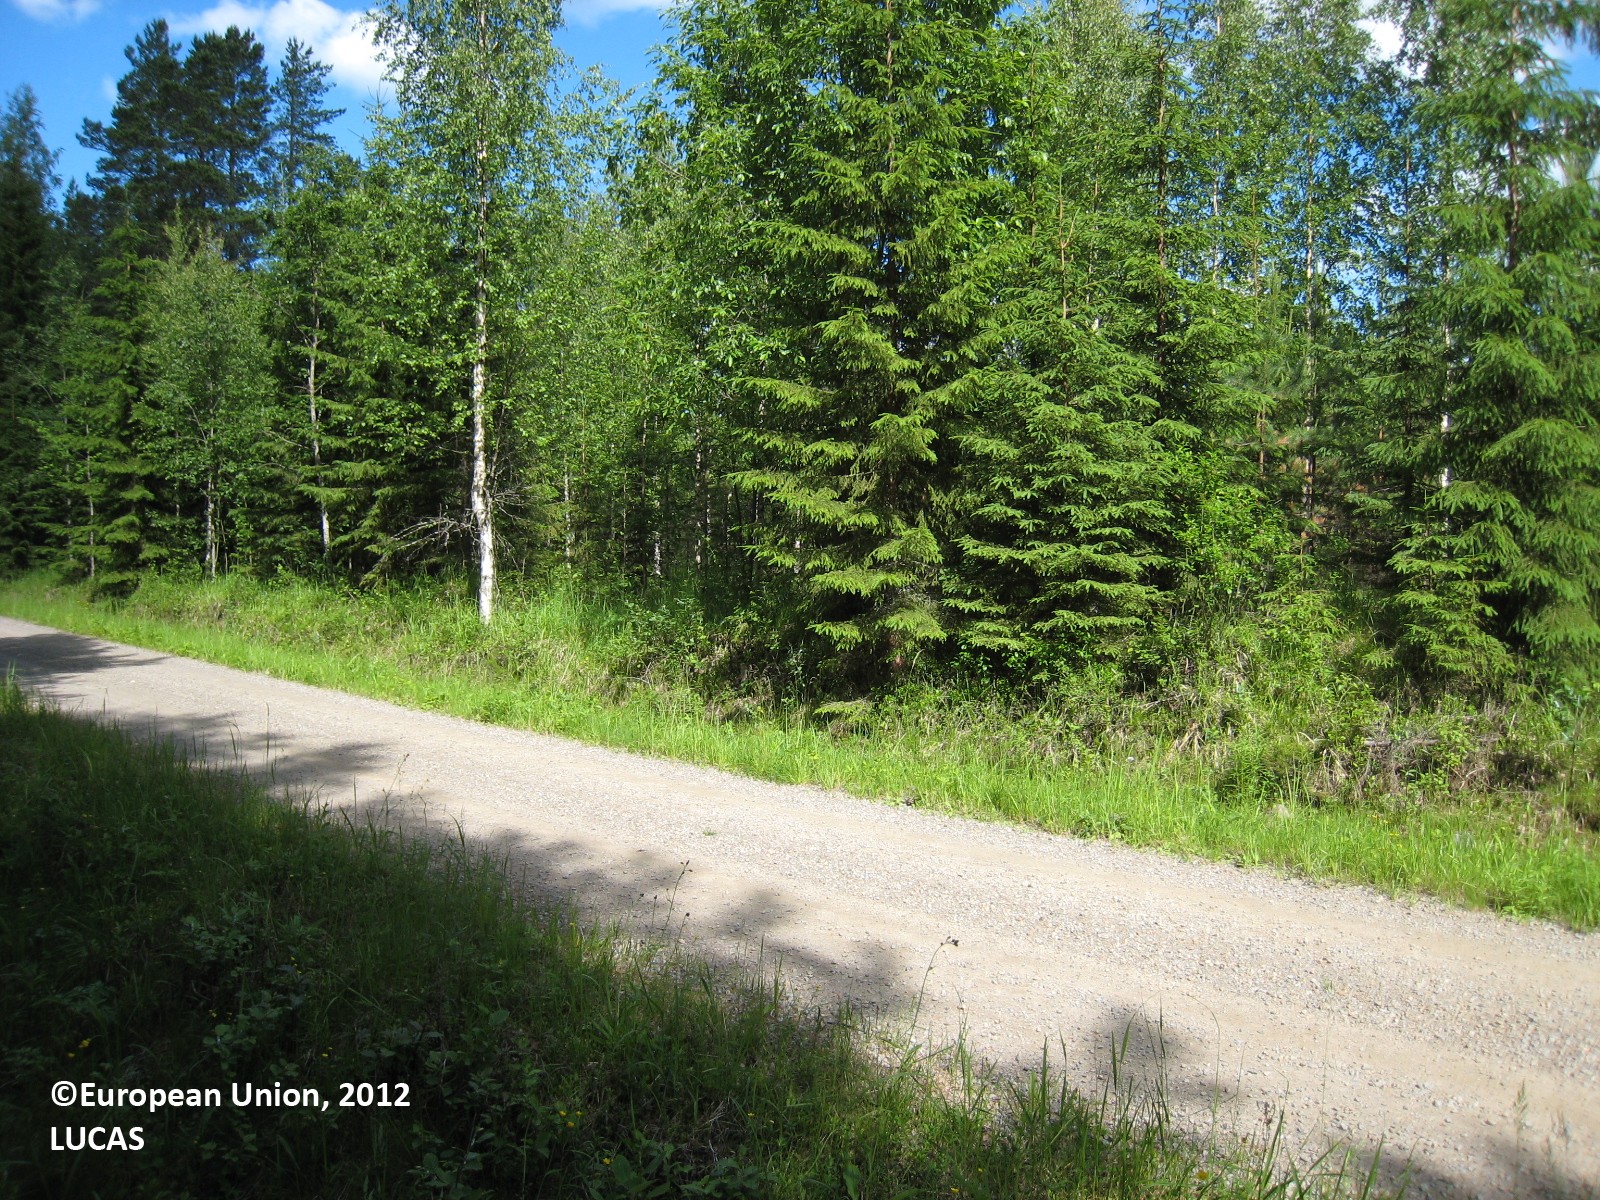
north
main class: Woodland
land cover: Other mixed woodland
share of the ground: 50 - 75 %
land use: Forestry
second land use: Road transport
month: July
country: FI
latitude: 63.2226
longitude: 25.6868
